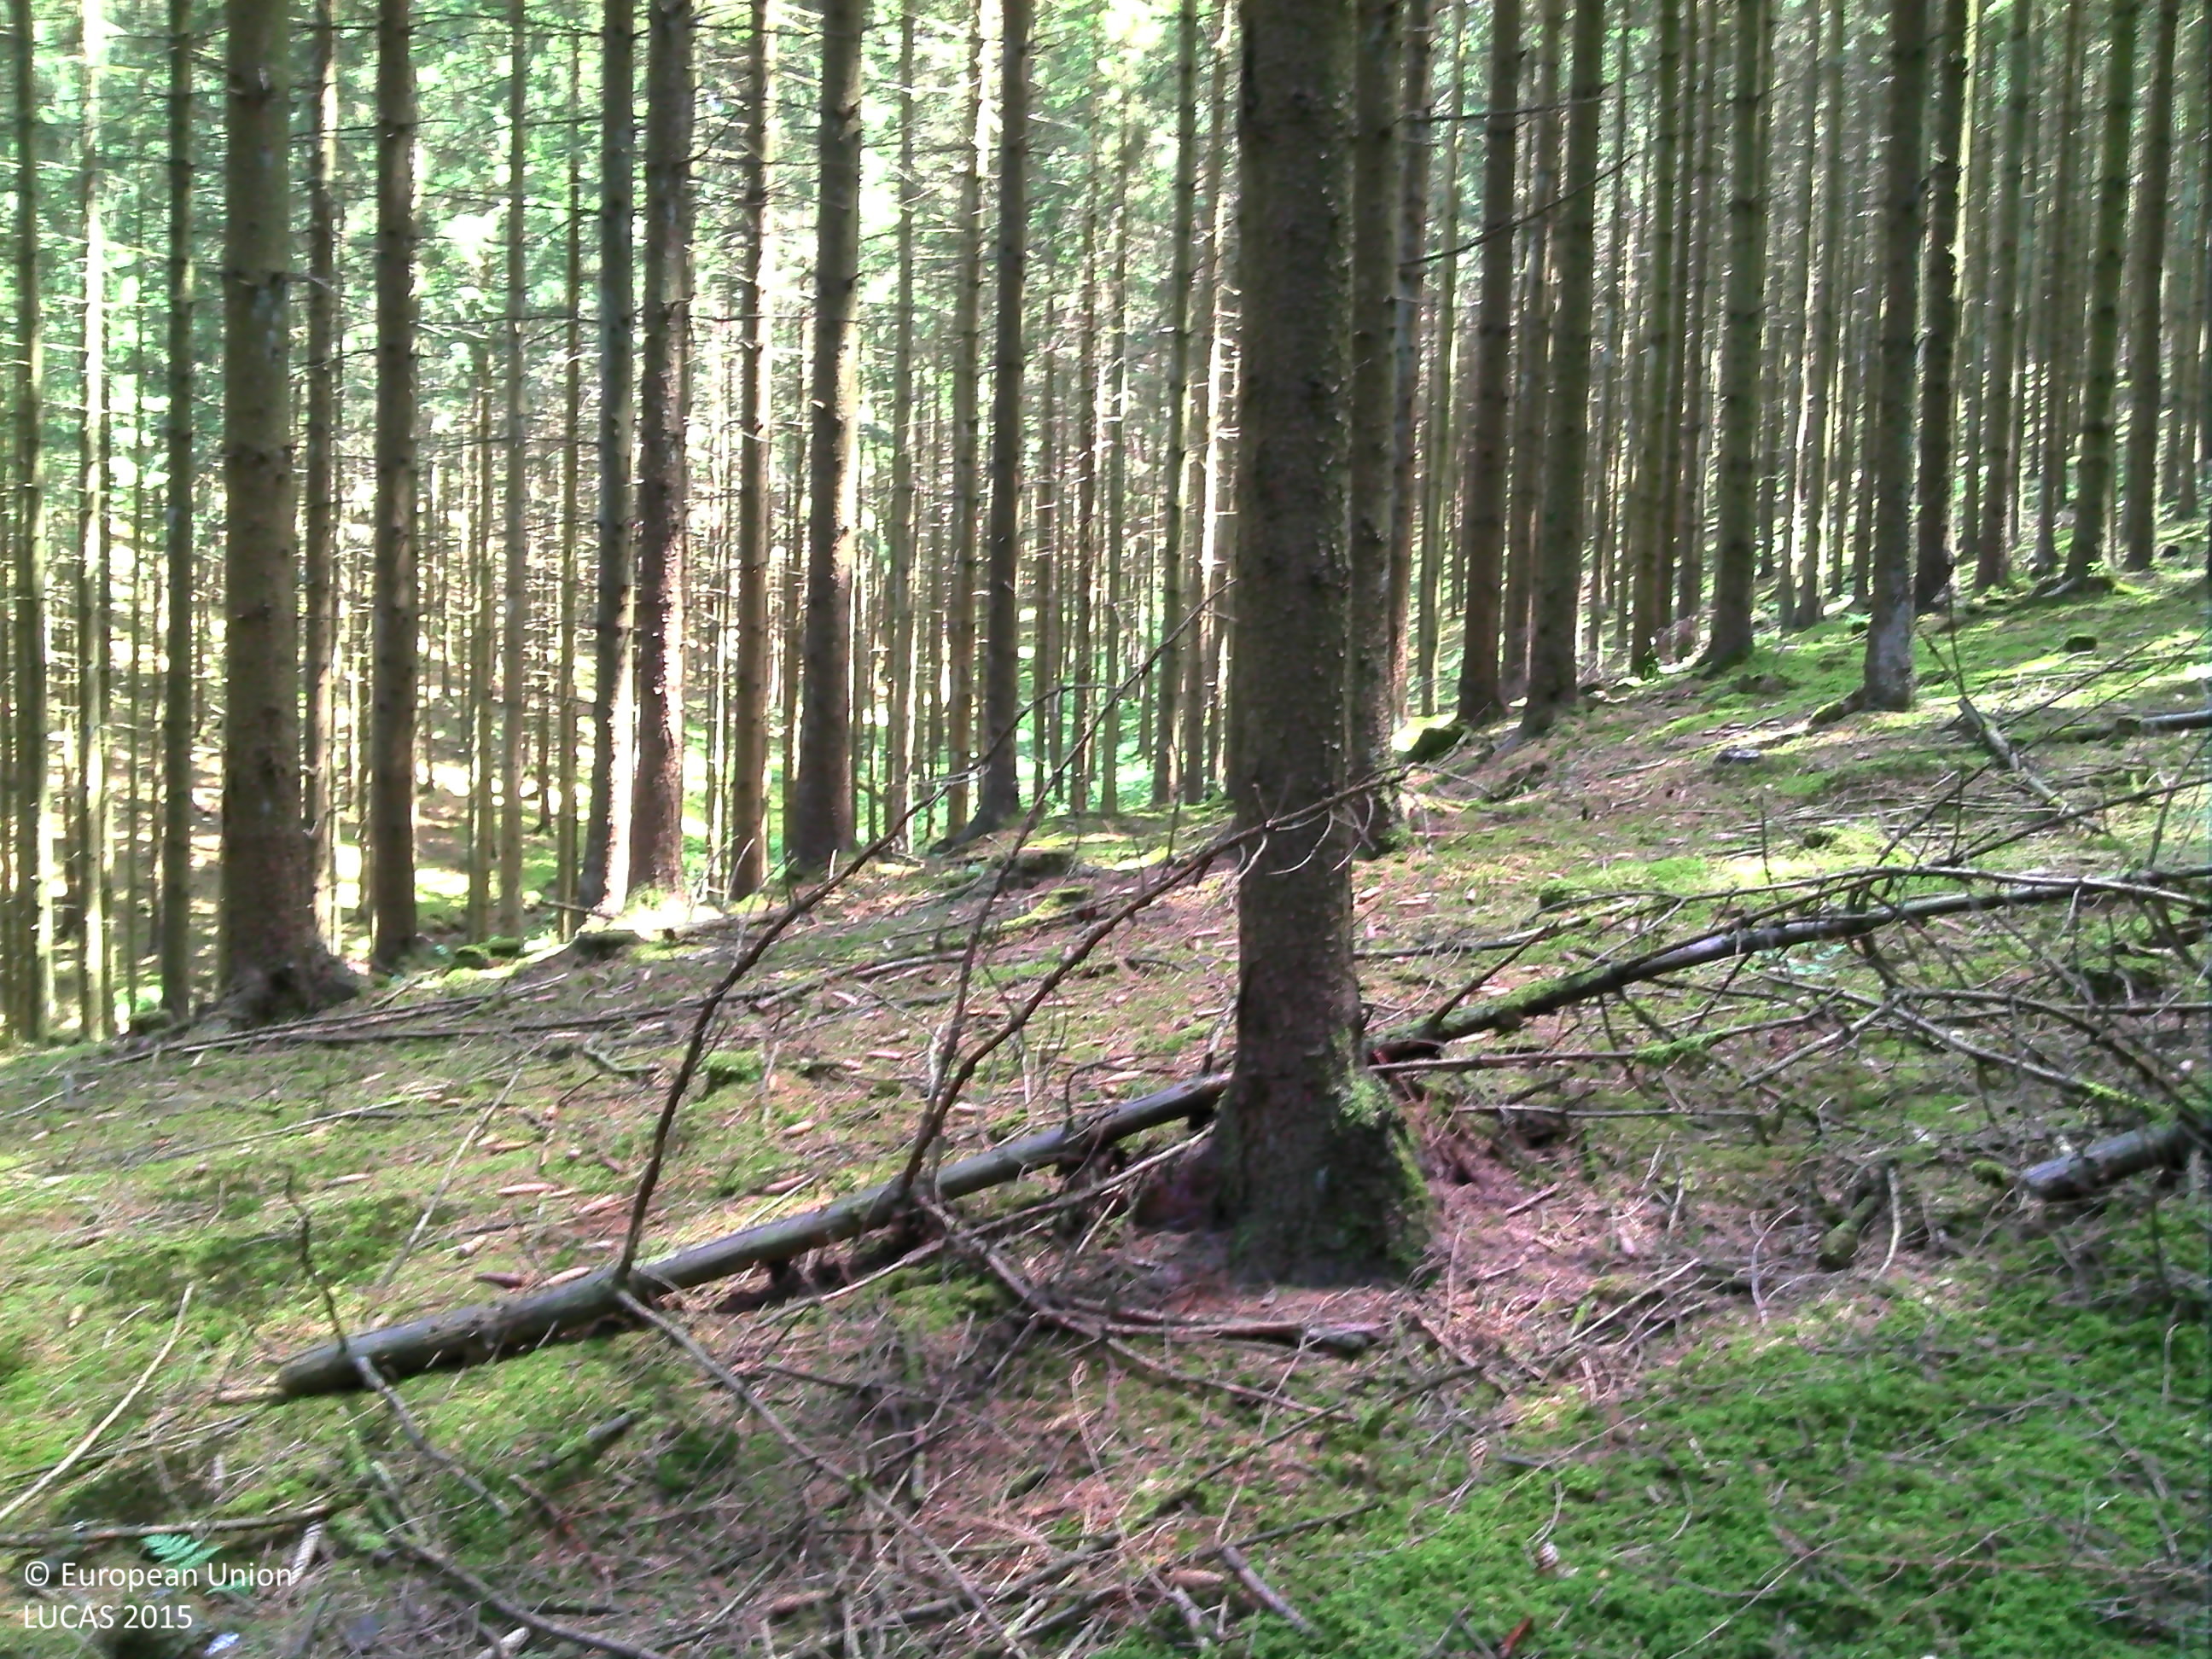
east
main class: Woodland
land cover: Spruce dominated coniferous woodland
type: exotic forest
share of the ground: > 75 %
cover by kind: coniferous forest trees 90 %, lichens and mosses 10 %
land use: Forestry
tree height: > 5 m
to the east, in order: Spruce dominated coniferous woodland; Rivers and streams; Spruce dominated coniferous woodland
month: July
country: BE
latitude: 50.2856
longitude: 6.2802
